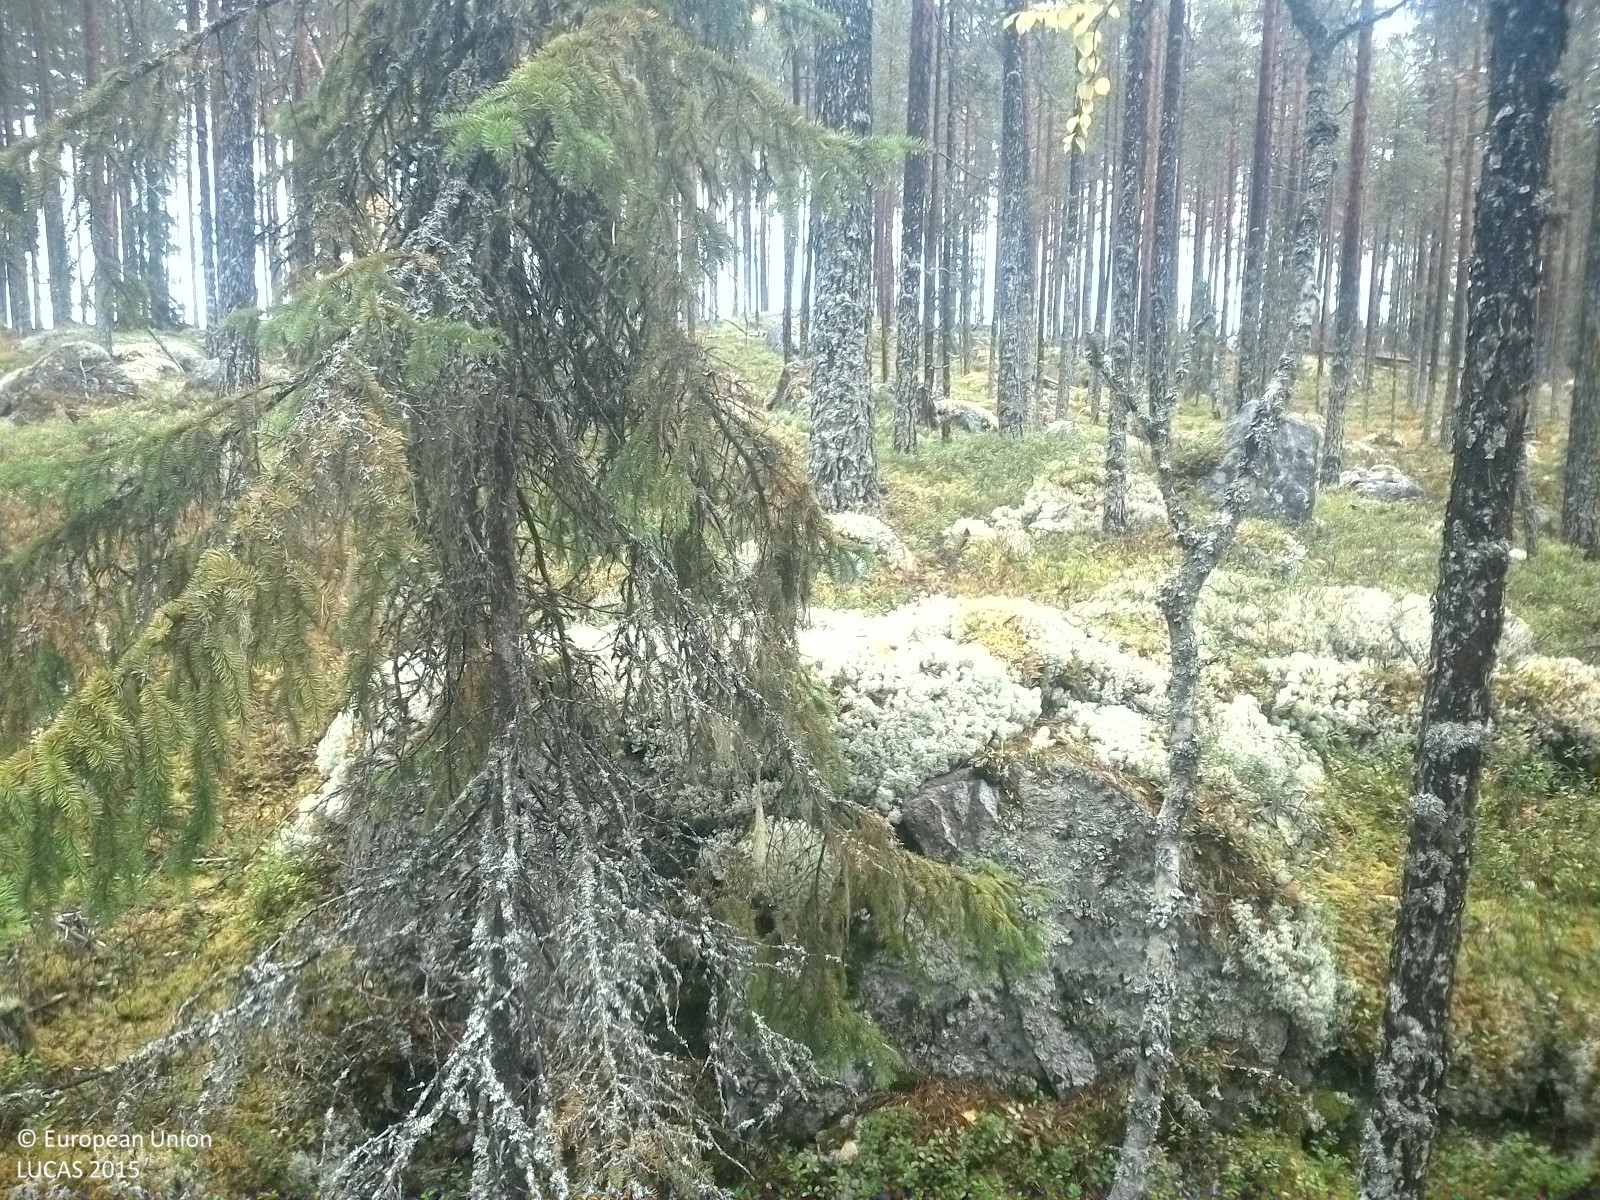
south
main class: Woodland
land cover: Pine dominated coniferous woodland
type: boreal forest
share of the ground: 25 - 50 %
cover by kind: coniferous forest trees 40 %, lichens and mosses 40 %, shrubs 20 %
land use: Forestry
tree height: > 5 m
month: September
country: SE
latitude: 62.2155
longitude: 15.6920
